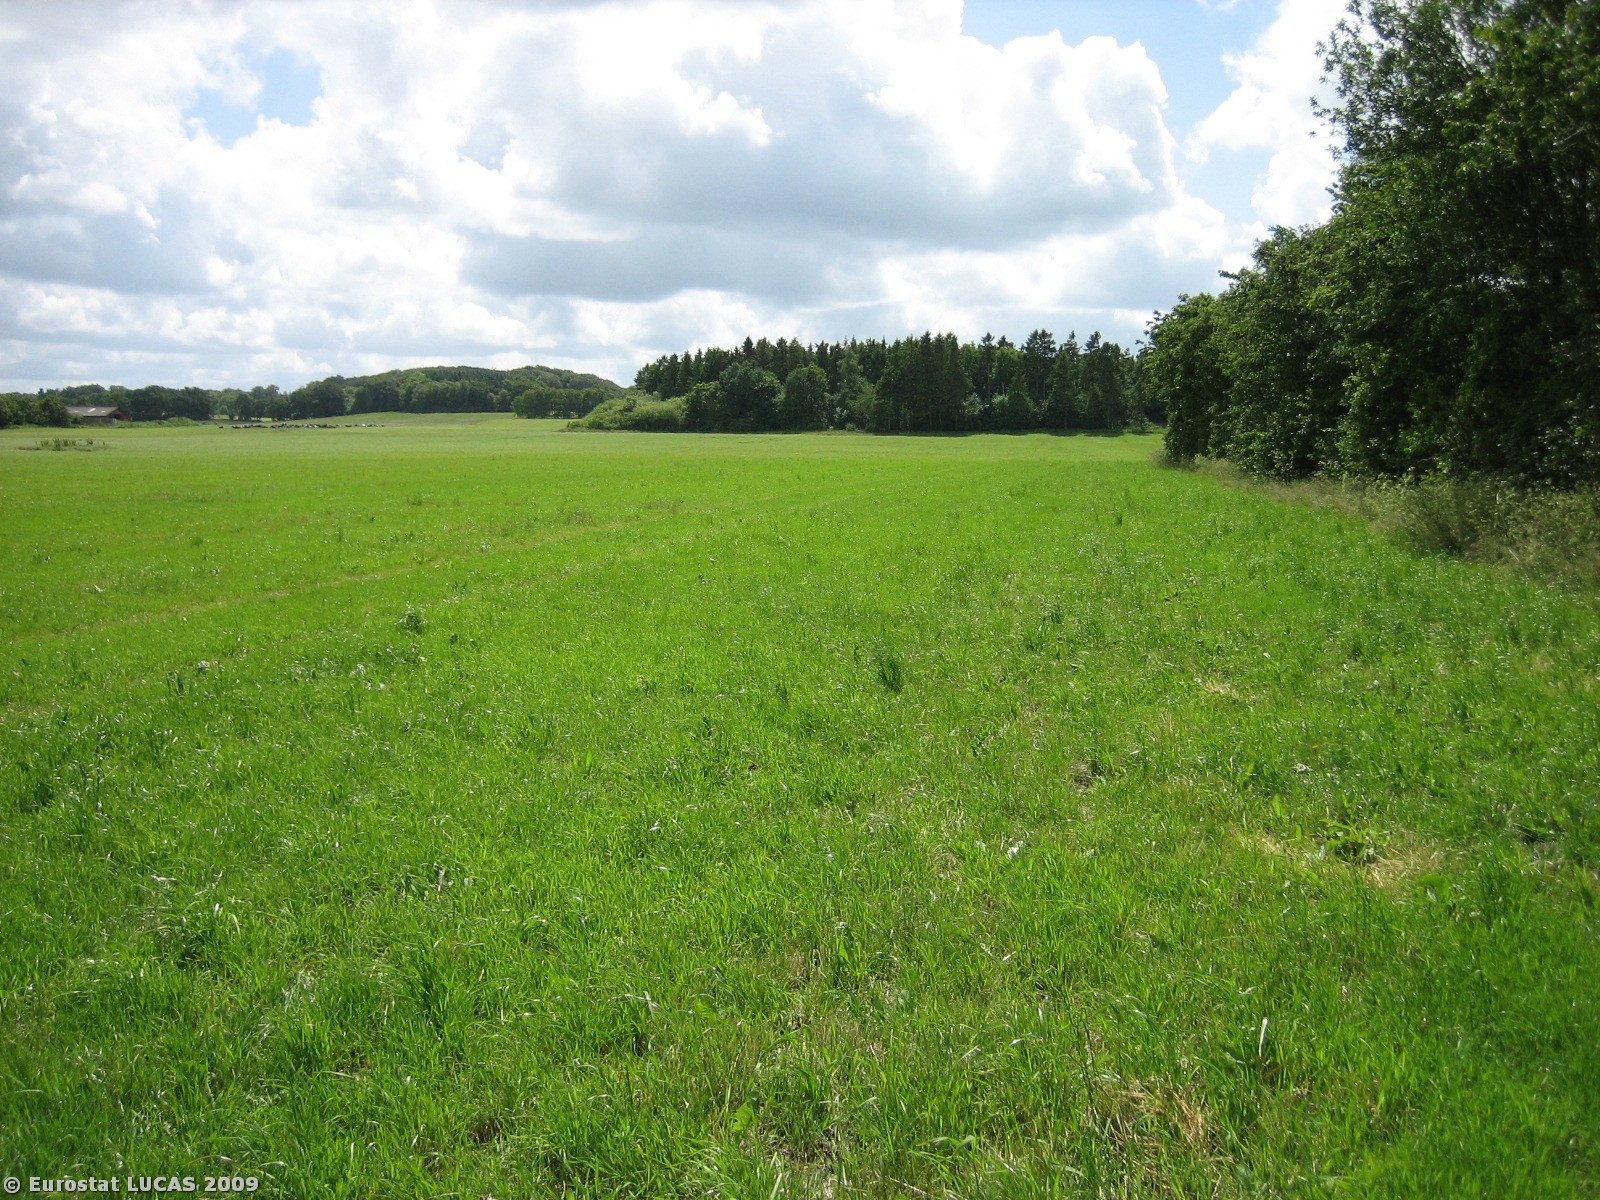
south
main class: Cropland
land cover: Temporary grasslands
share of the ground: > 75 %
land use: Agriculture (excluding fallow land and kitchen gardens)
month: June
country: DK
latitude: 55.7719
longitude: 9.2197
